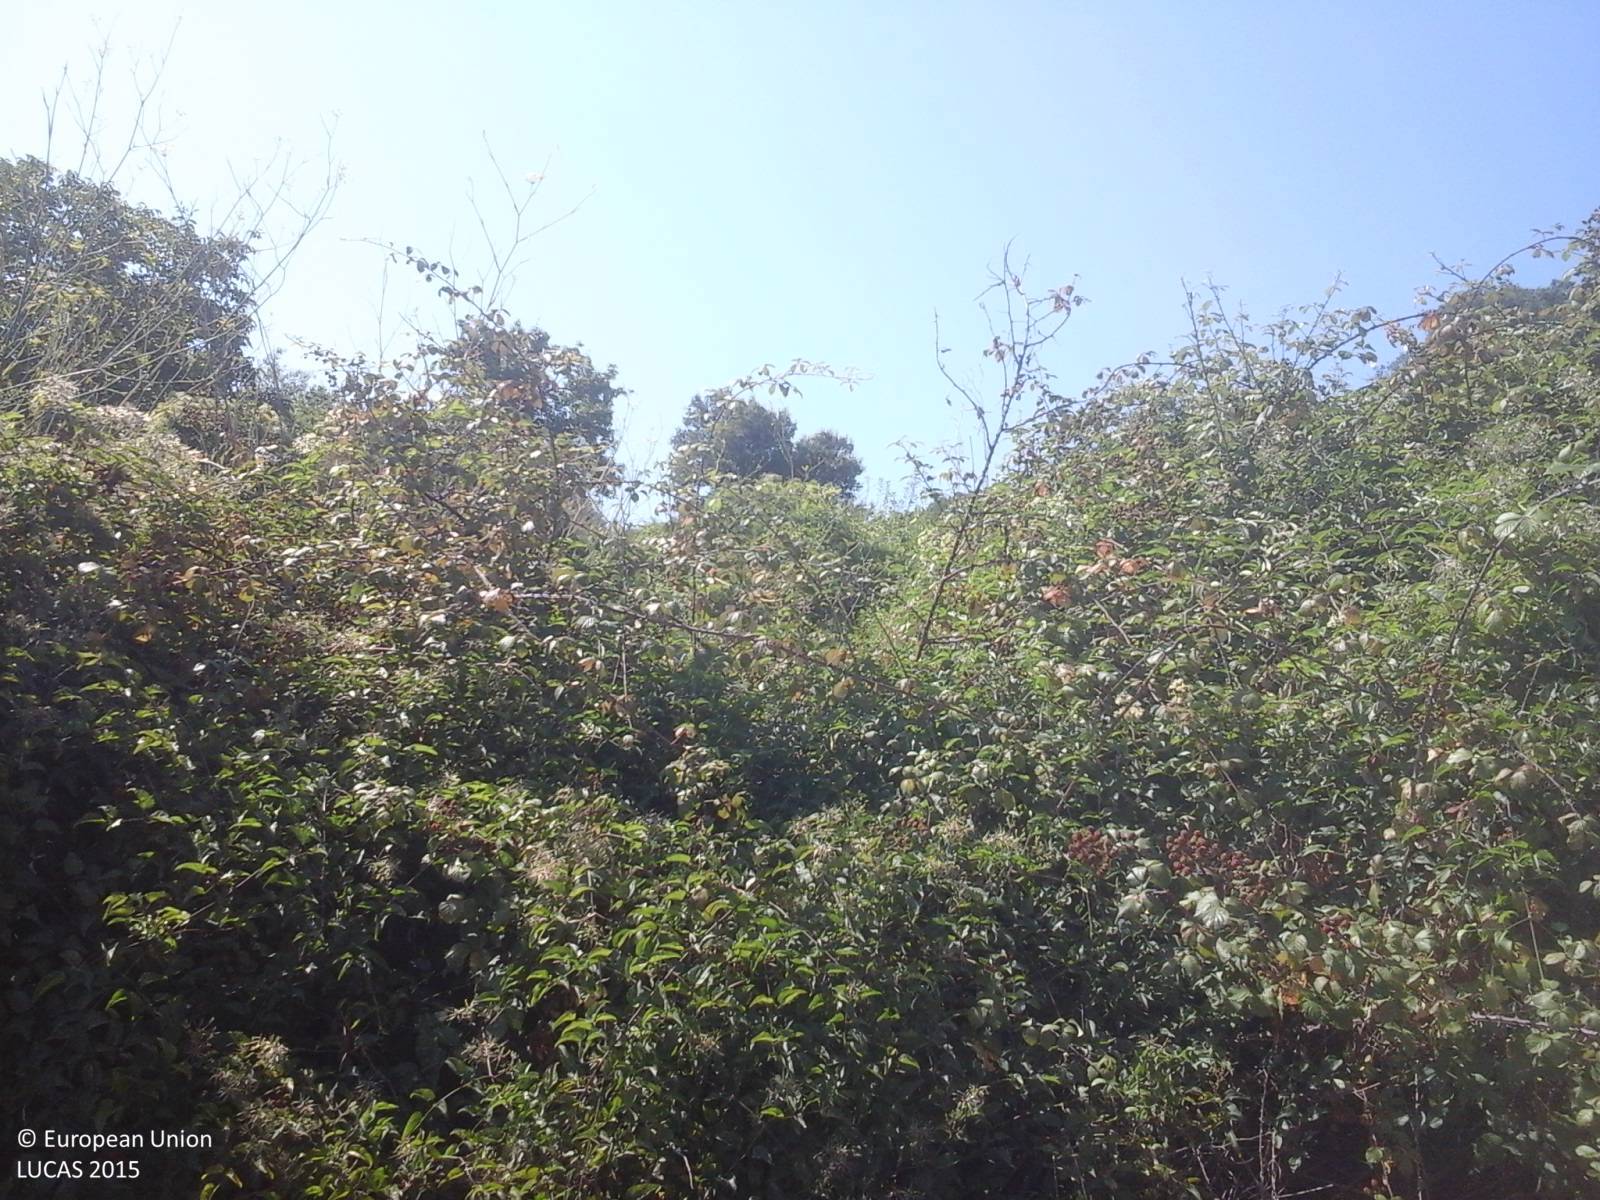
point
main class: Shrubland
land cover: Shrubland without tree cover
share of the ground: > 75 %
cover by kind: unconsolidated bare surface 55 %, shrubs 45 %
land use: Agriculture (excluding fallow land and kitchen gardens)
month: July
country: IT
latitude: 39.5229
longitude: 9.3871
